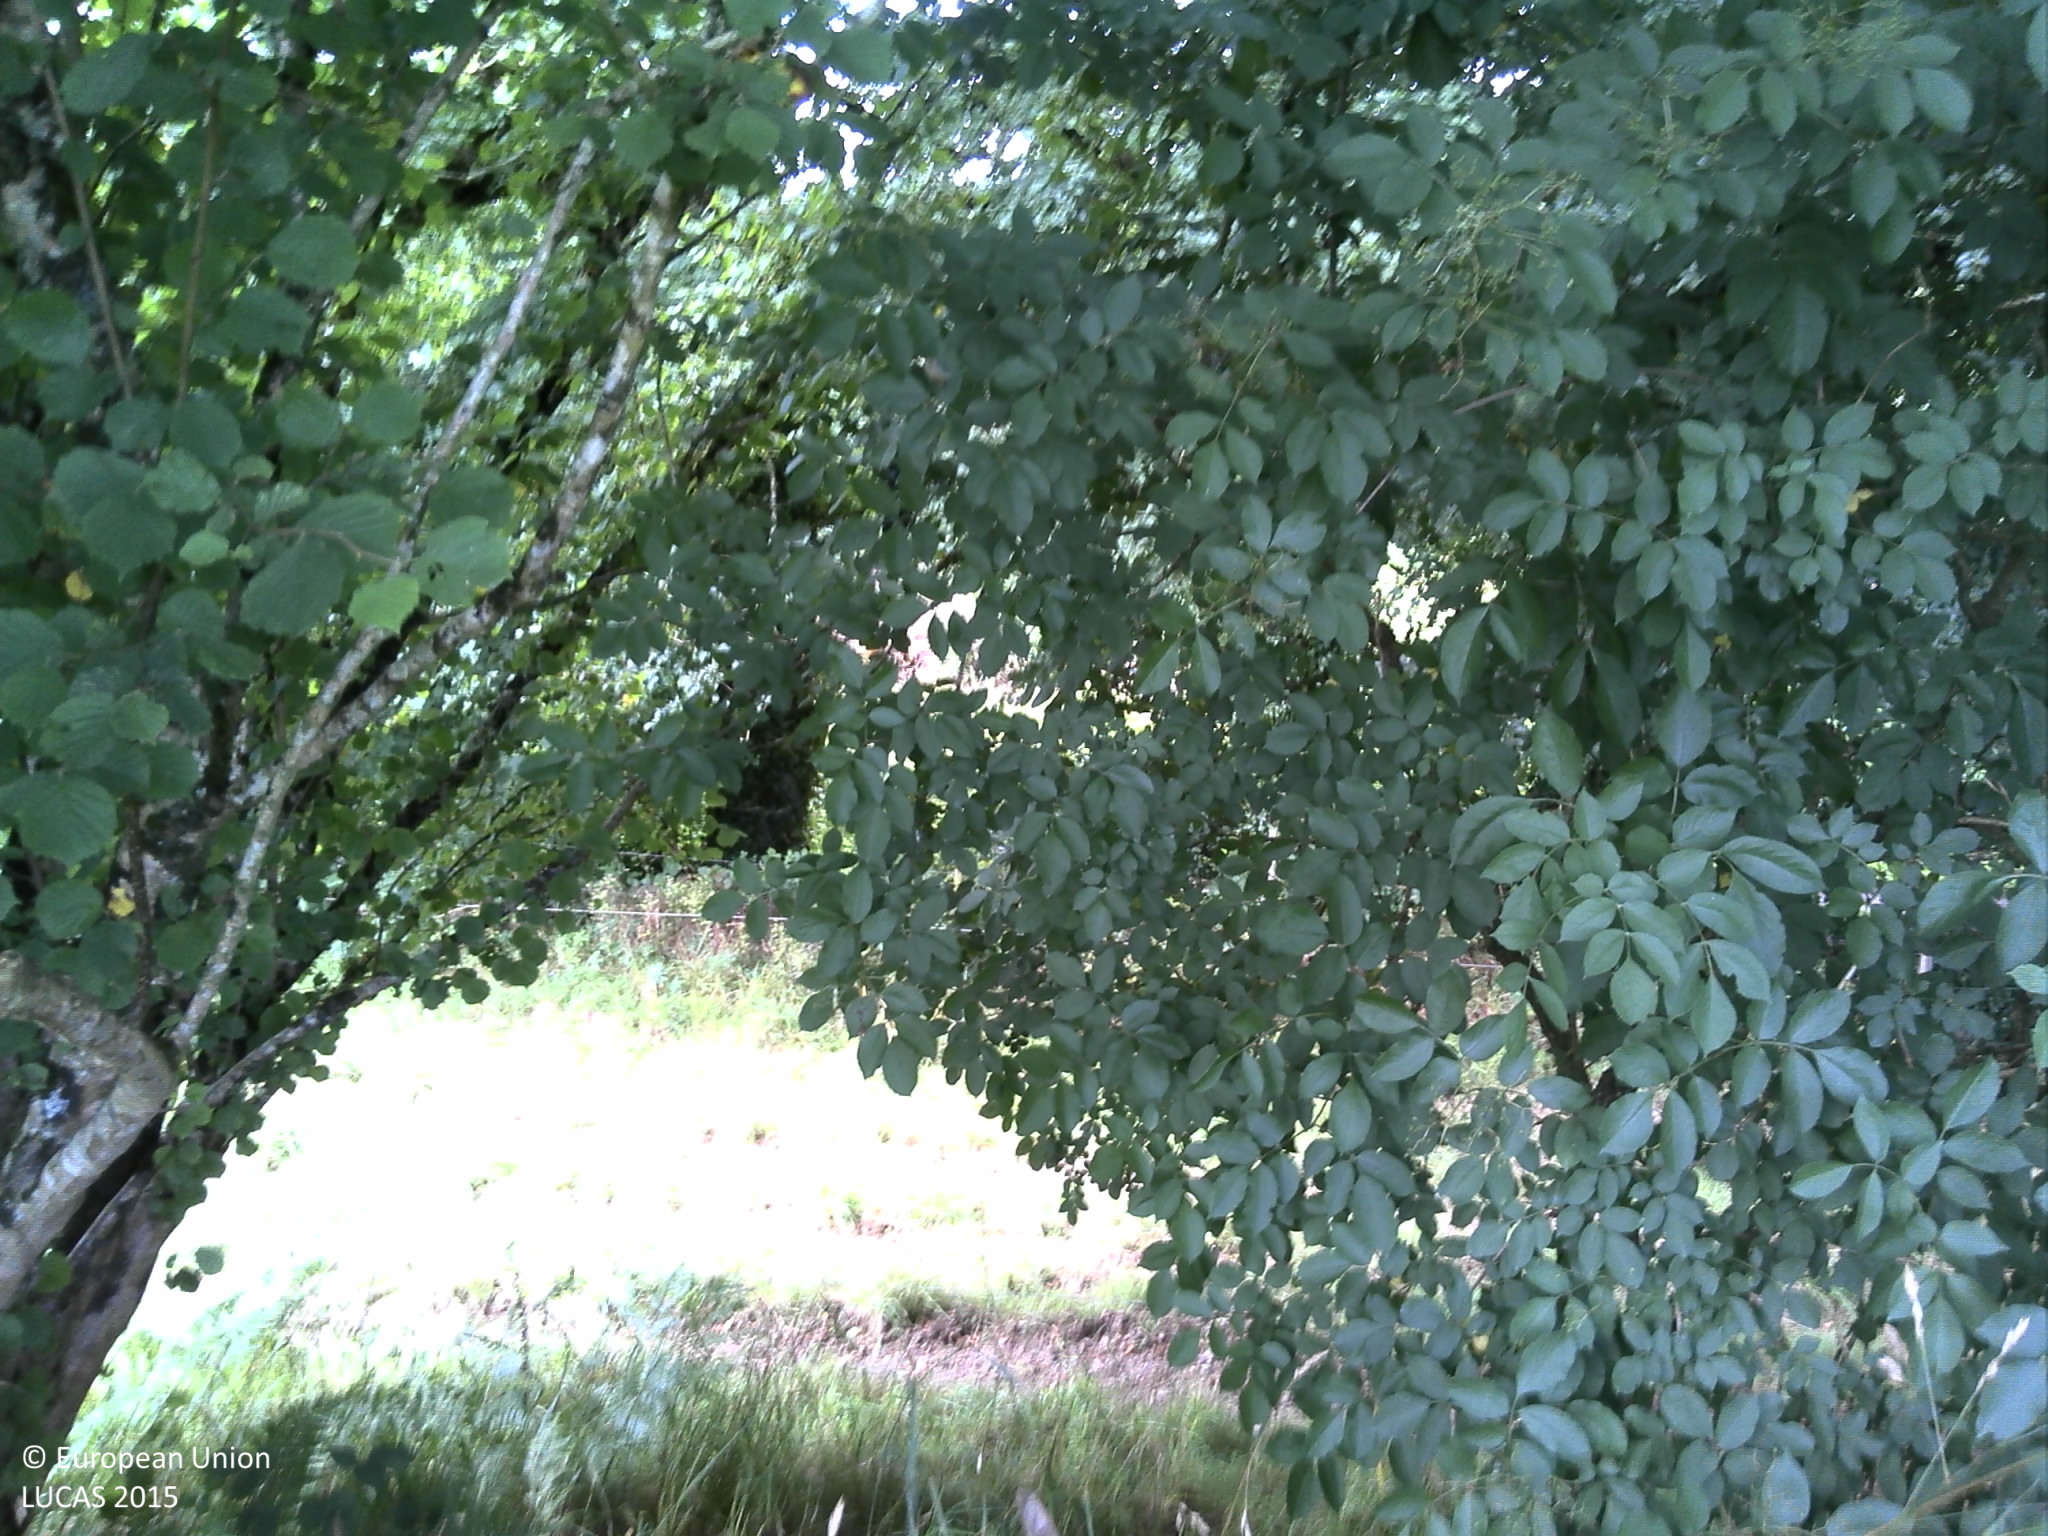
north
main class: Woodland
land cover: Broadleaved woodland
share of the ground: > 75 %
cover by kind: broadleaved forest trees 90 %, herbaceous plants 10 %
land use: Agriculture (excluding fallow land and kitchen gardens)
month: July
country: FR
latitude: 48.2850
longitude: -3.6246
